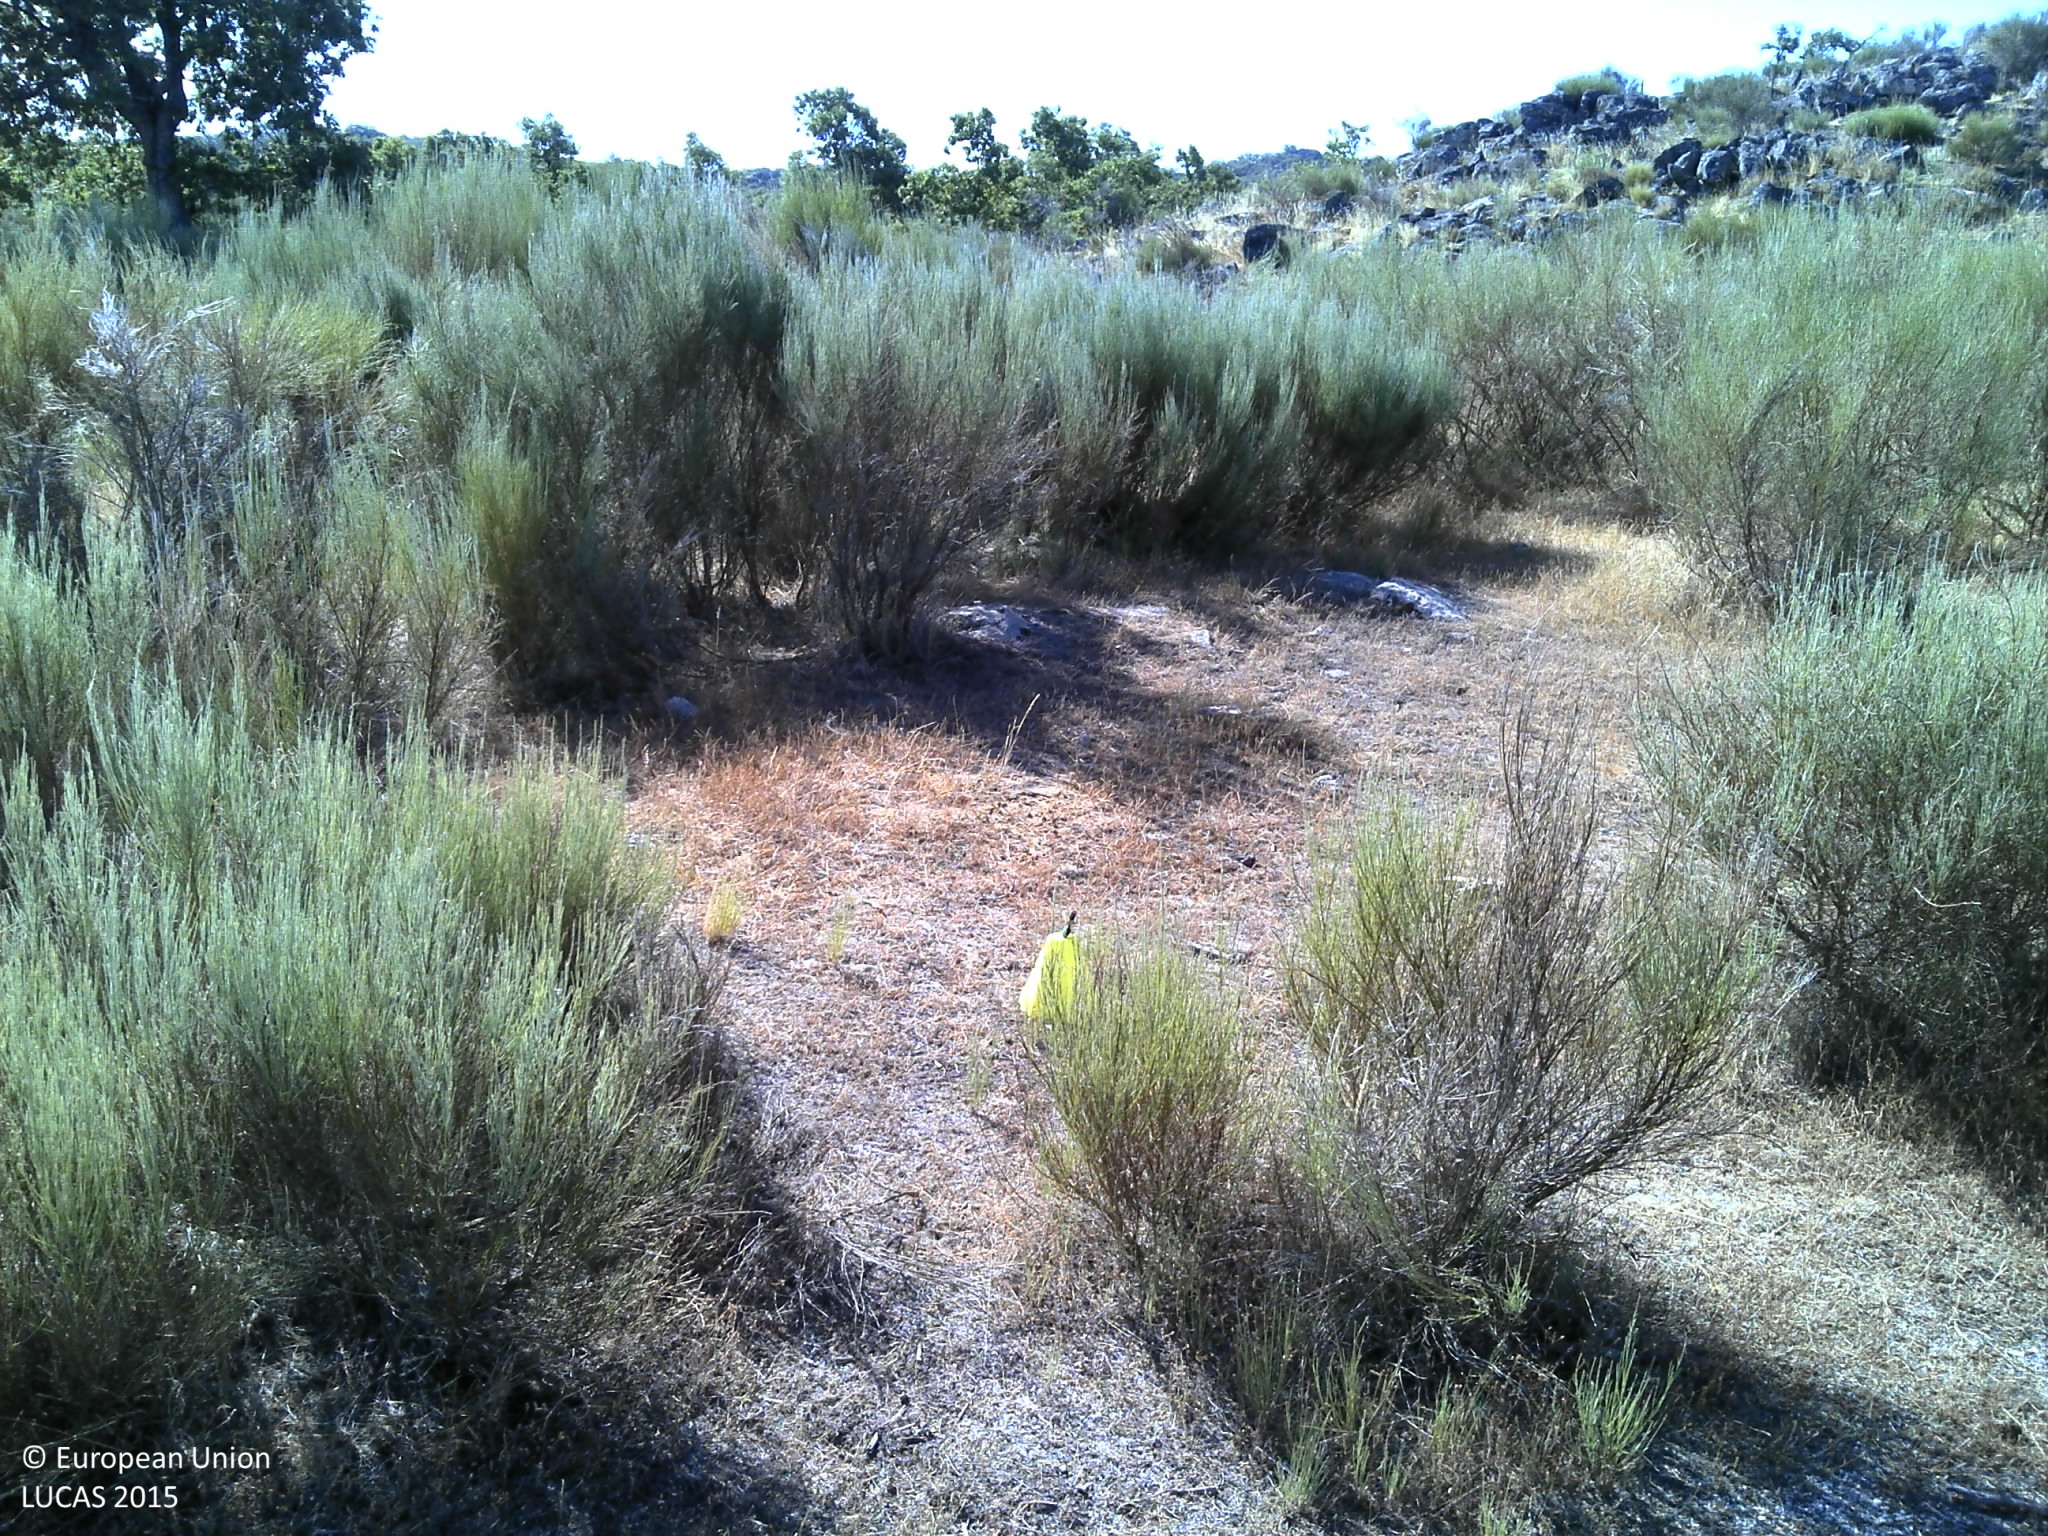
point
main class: Shrubland
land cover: Shrubland without tree cover
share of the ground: 50 - 75 %
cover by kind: shrubs 50 %, herbaceous plants 30 %, consolidated bare surface 20 %
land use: Agriculture (excluding fallow land and kitchen gardens)
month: August
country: PT
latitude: 39.4350
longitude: -7.4127
